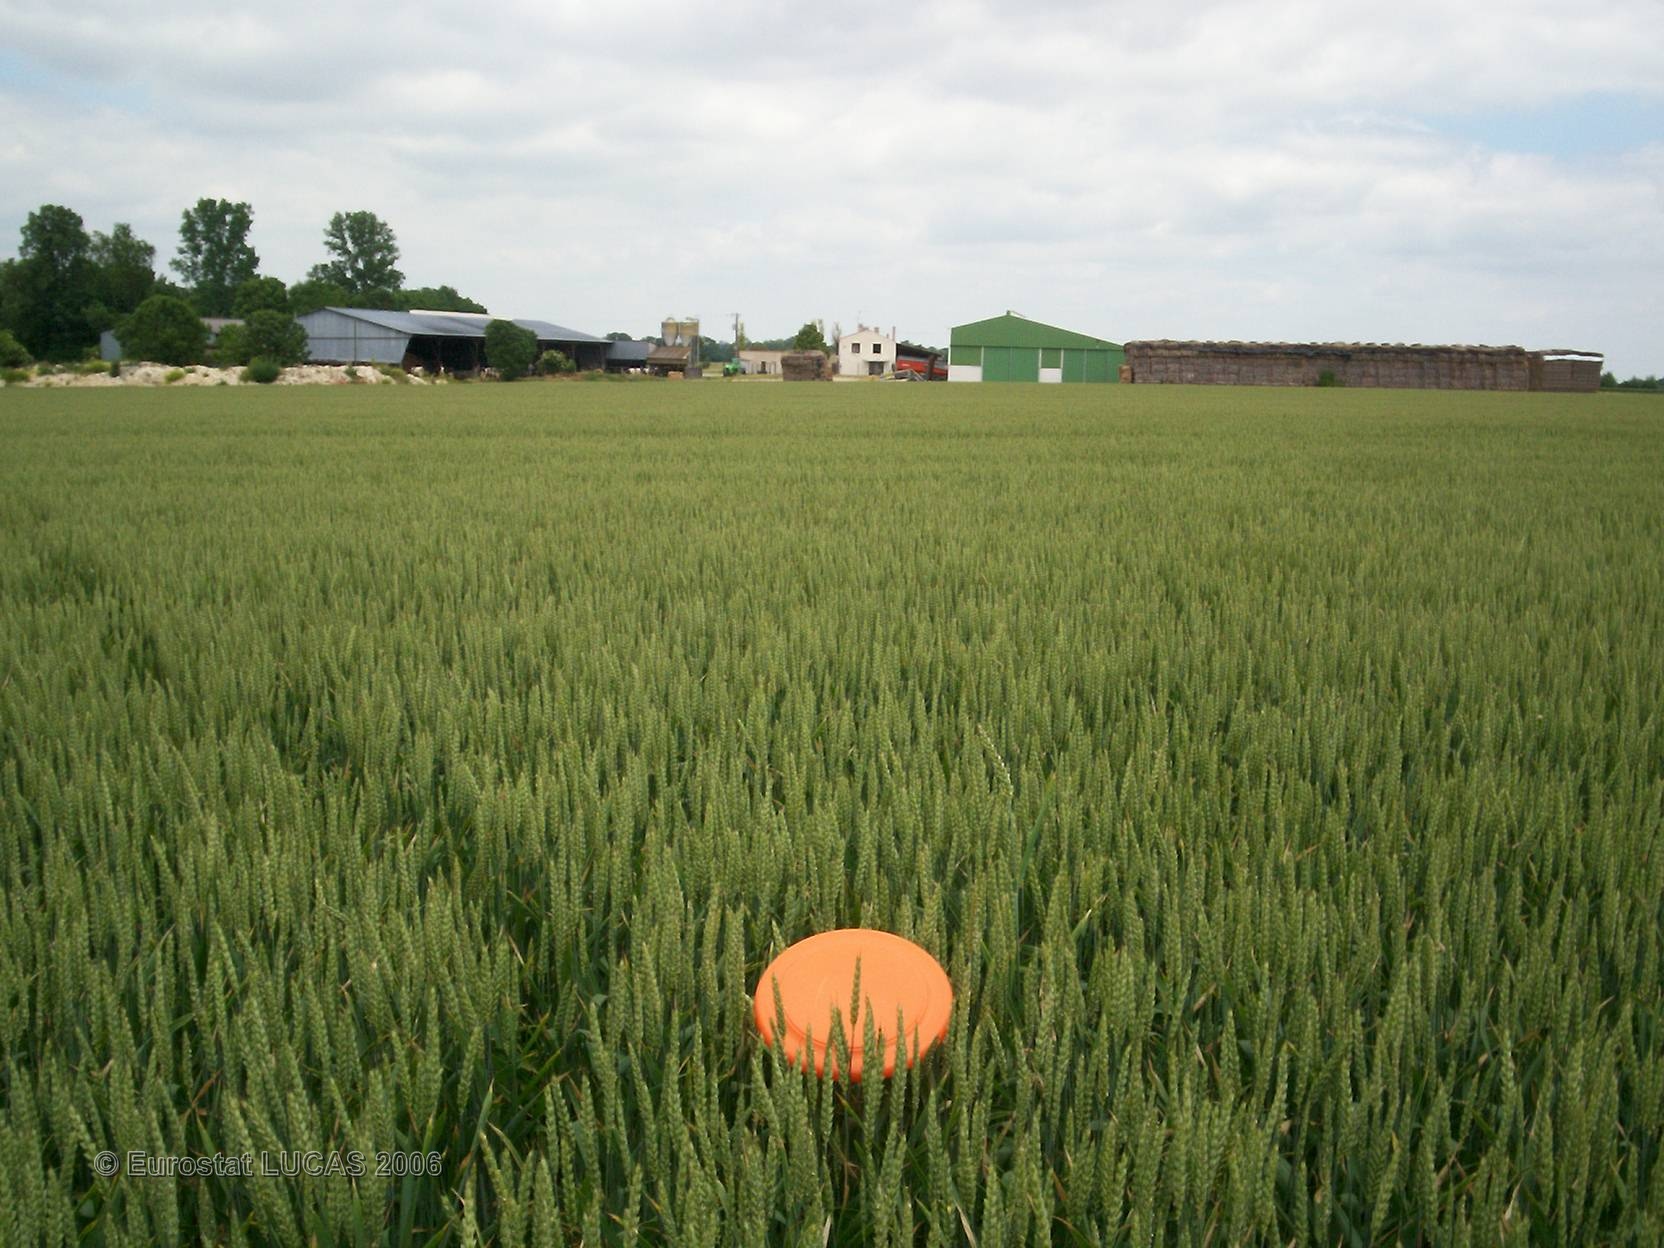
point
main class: Cropland
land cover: Common wheat
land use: Agriculture (excluding fallow land and kitchen gardens)
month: June
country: FR
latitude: 46.1183
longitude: -0.9115
